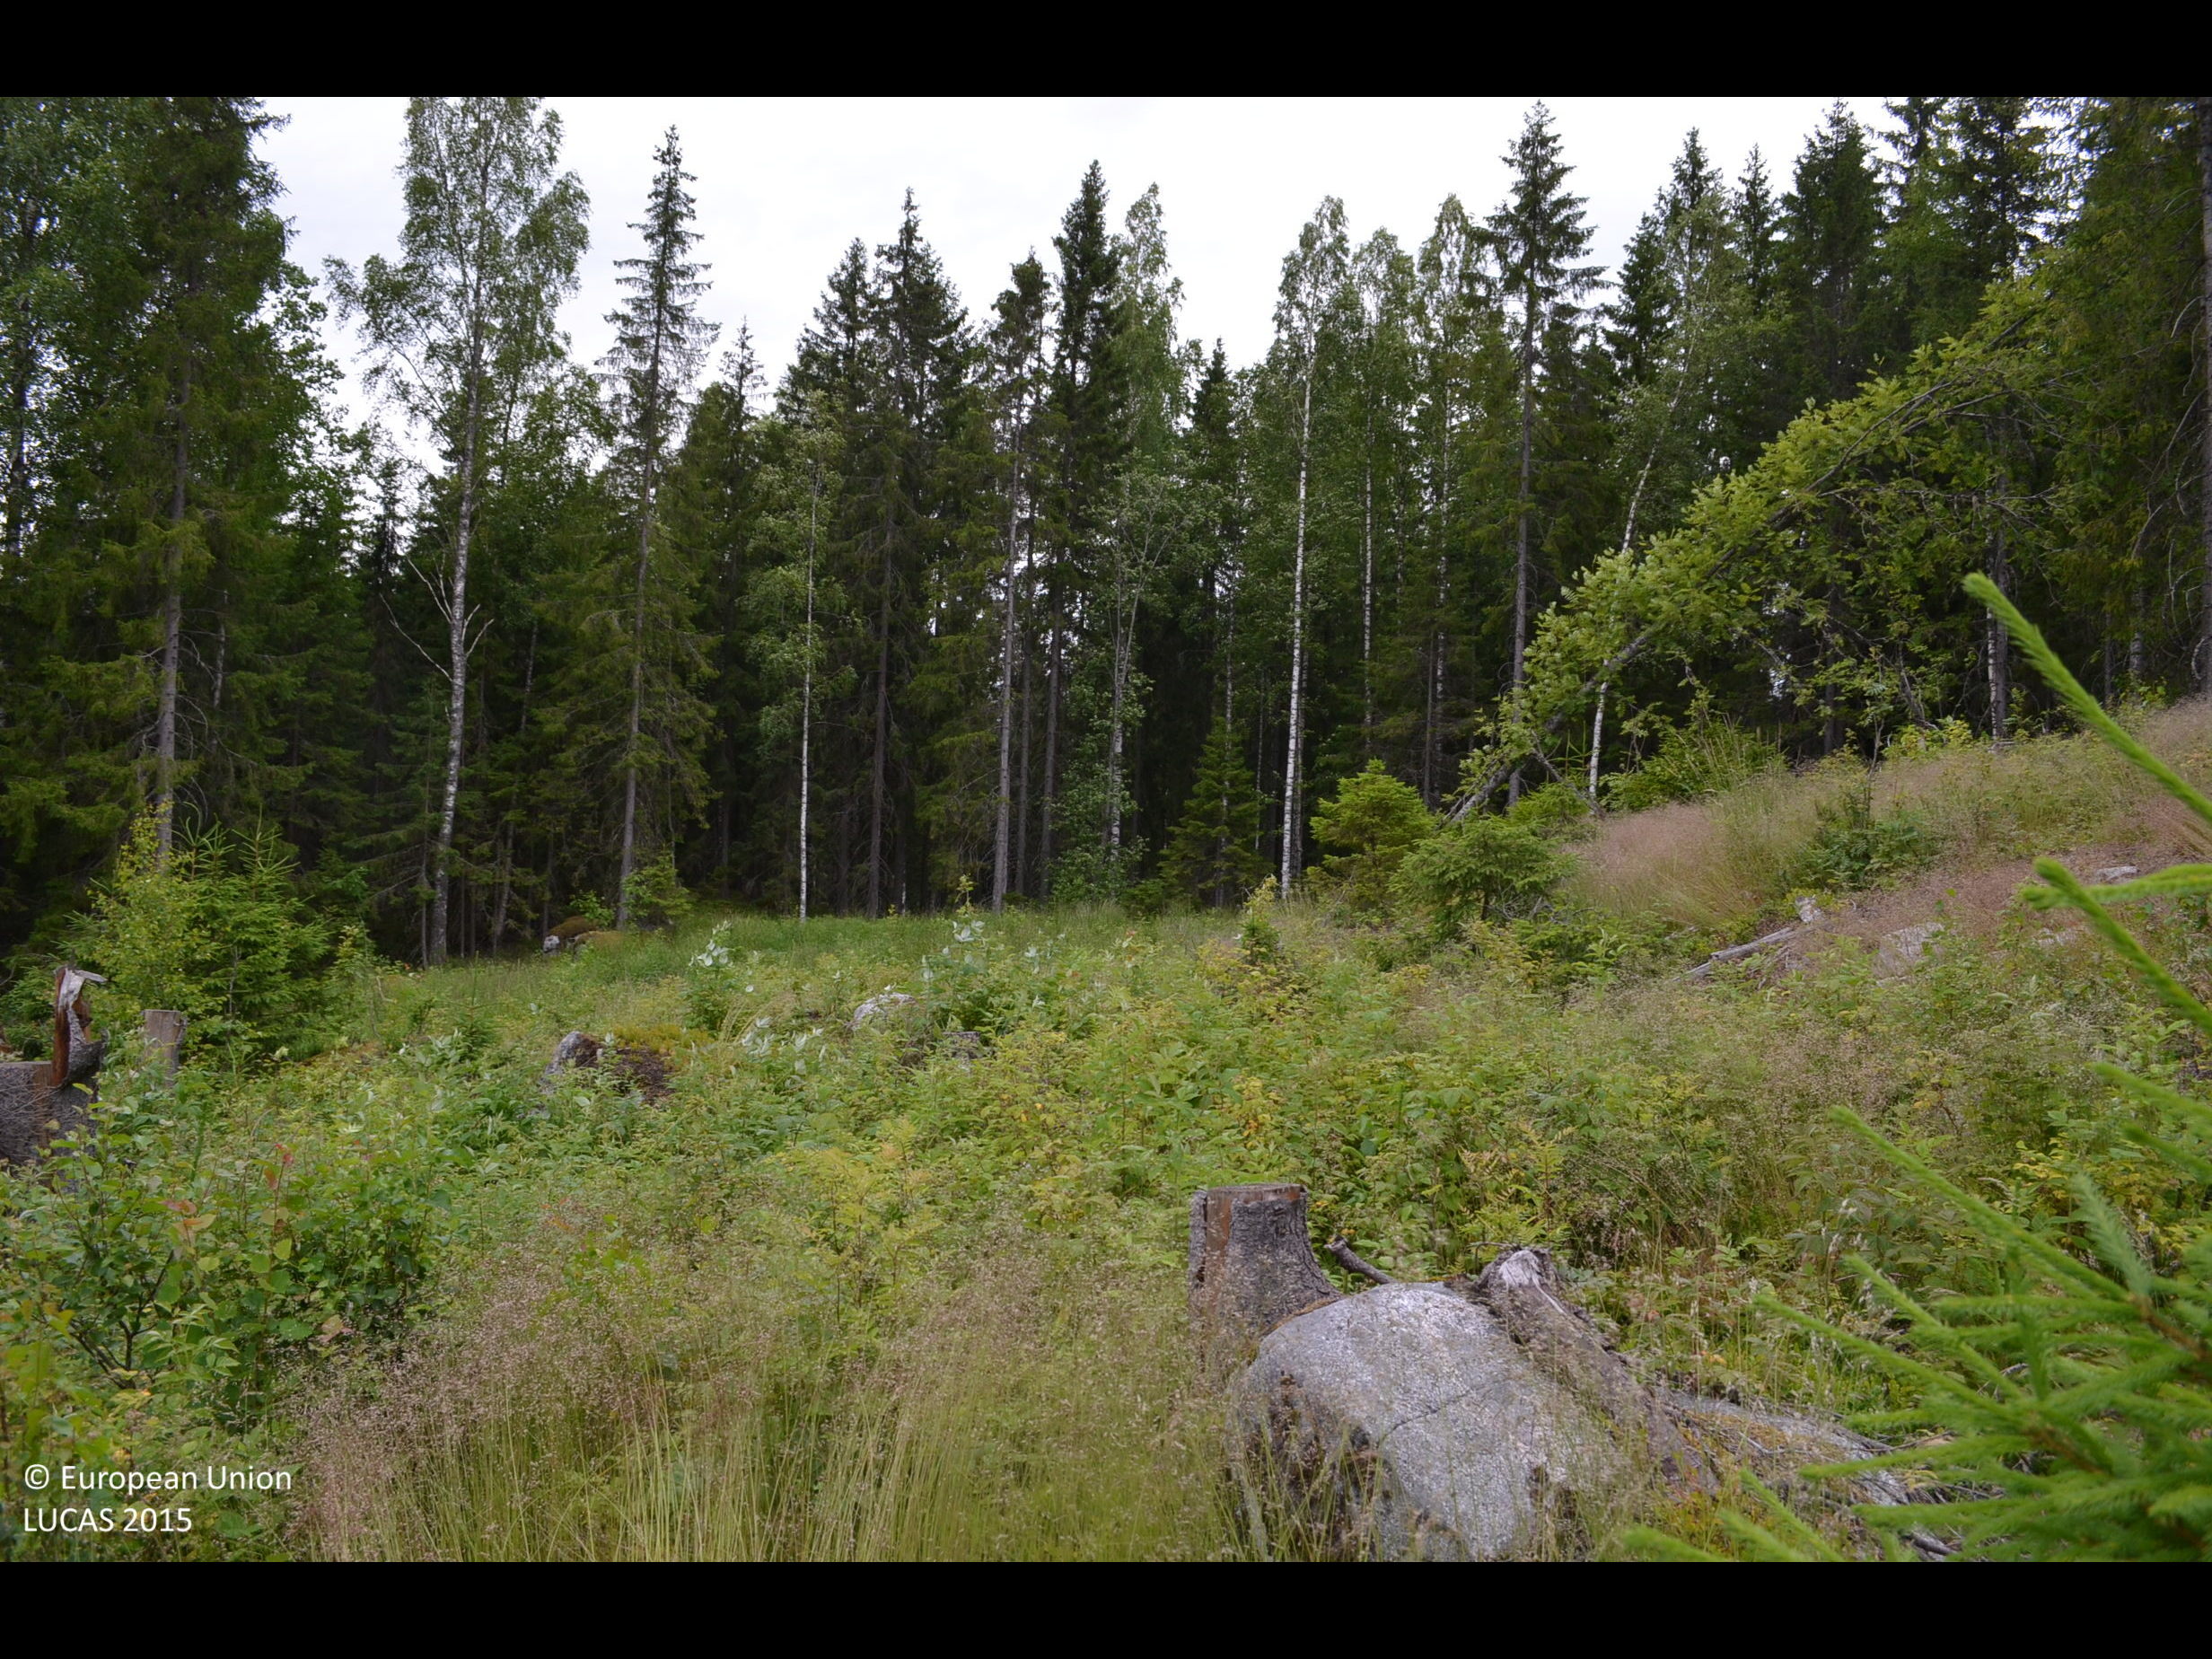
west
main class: Woodland
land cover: Spruce dominated mixed woodland
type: boreal forest
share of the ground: 25 - 50 %
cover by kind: herbaceous plants 60 %, broadleaved forest trees 20 %, coniferous forest trees 15 %, shrubs 5 %
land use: Forestry
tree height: < 5 m
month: July
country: FI
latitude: 61.6374
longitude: 23.2644
